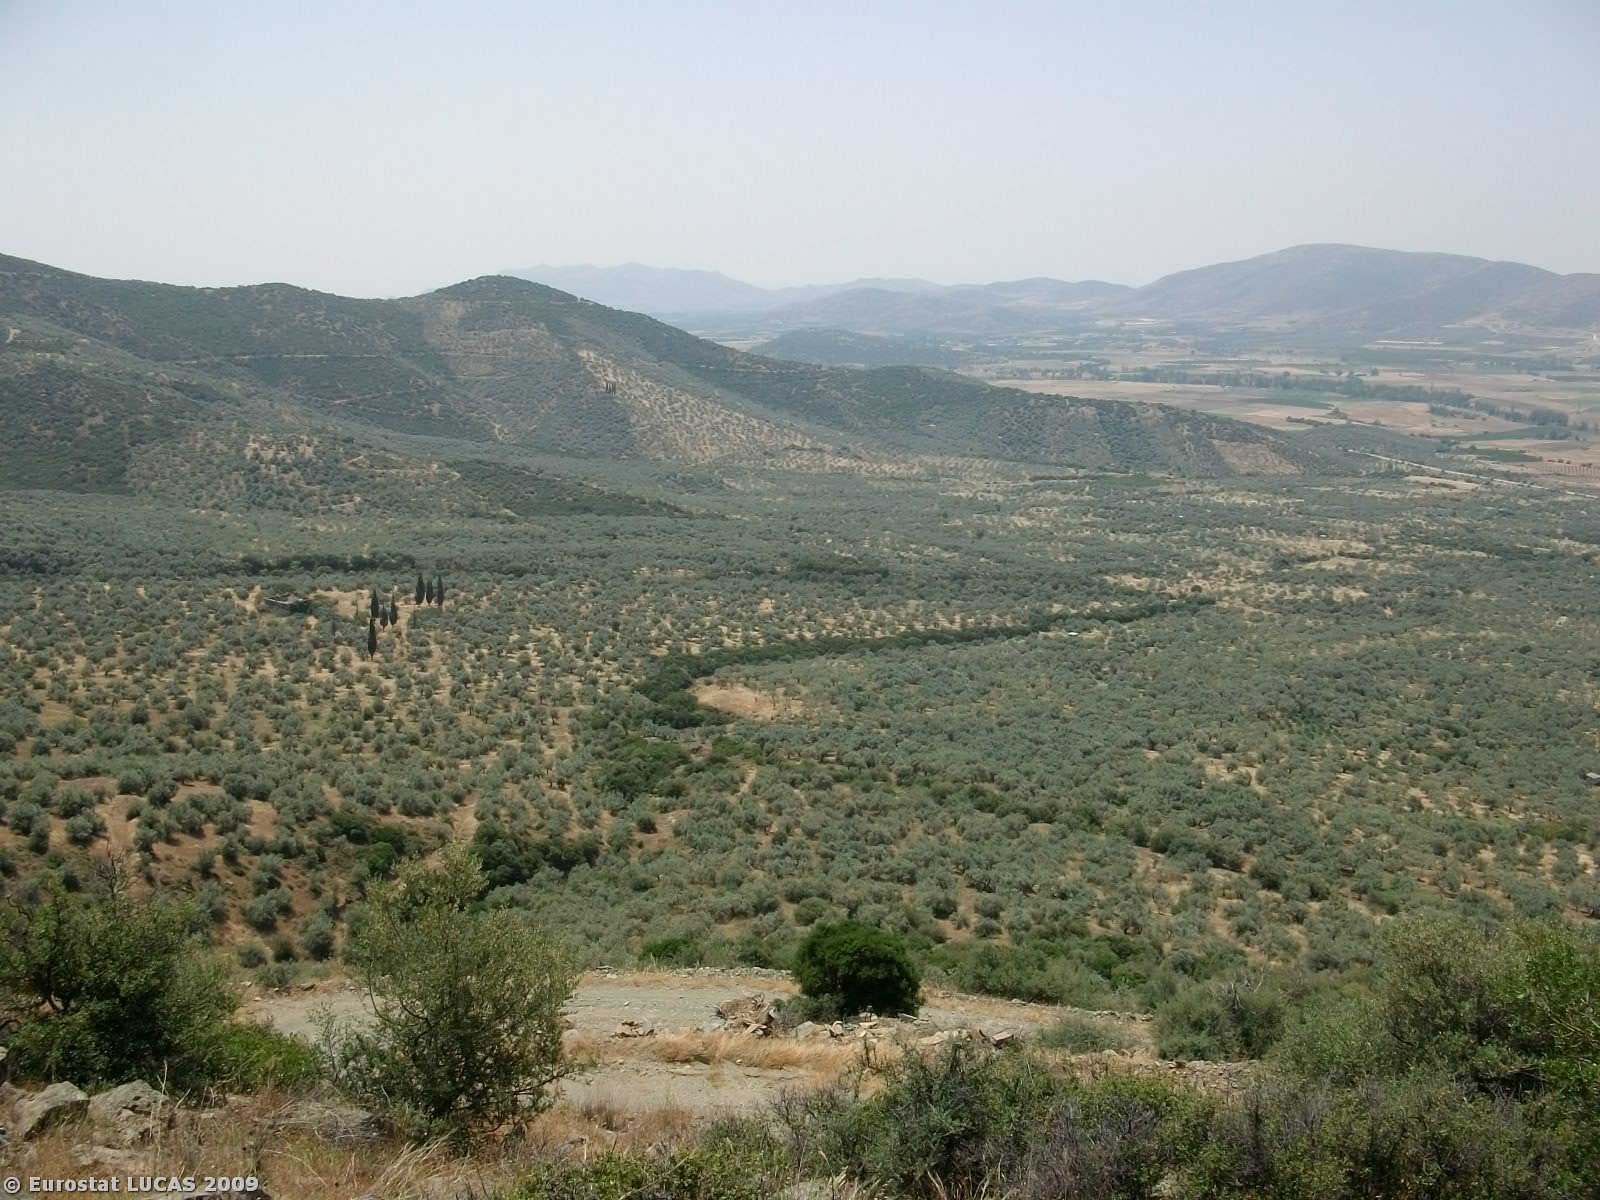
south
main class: Grassland
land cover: Grassland with sparse tree/shrub cover
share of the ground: 50 - 75 %
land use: Agriculture (excluding fallow land and kitchen gardens)
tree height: < 5 m
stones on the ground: 25 - 50 %
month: June
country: GR
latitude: 39.8056
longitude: 22.5493
